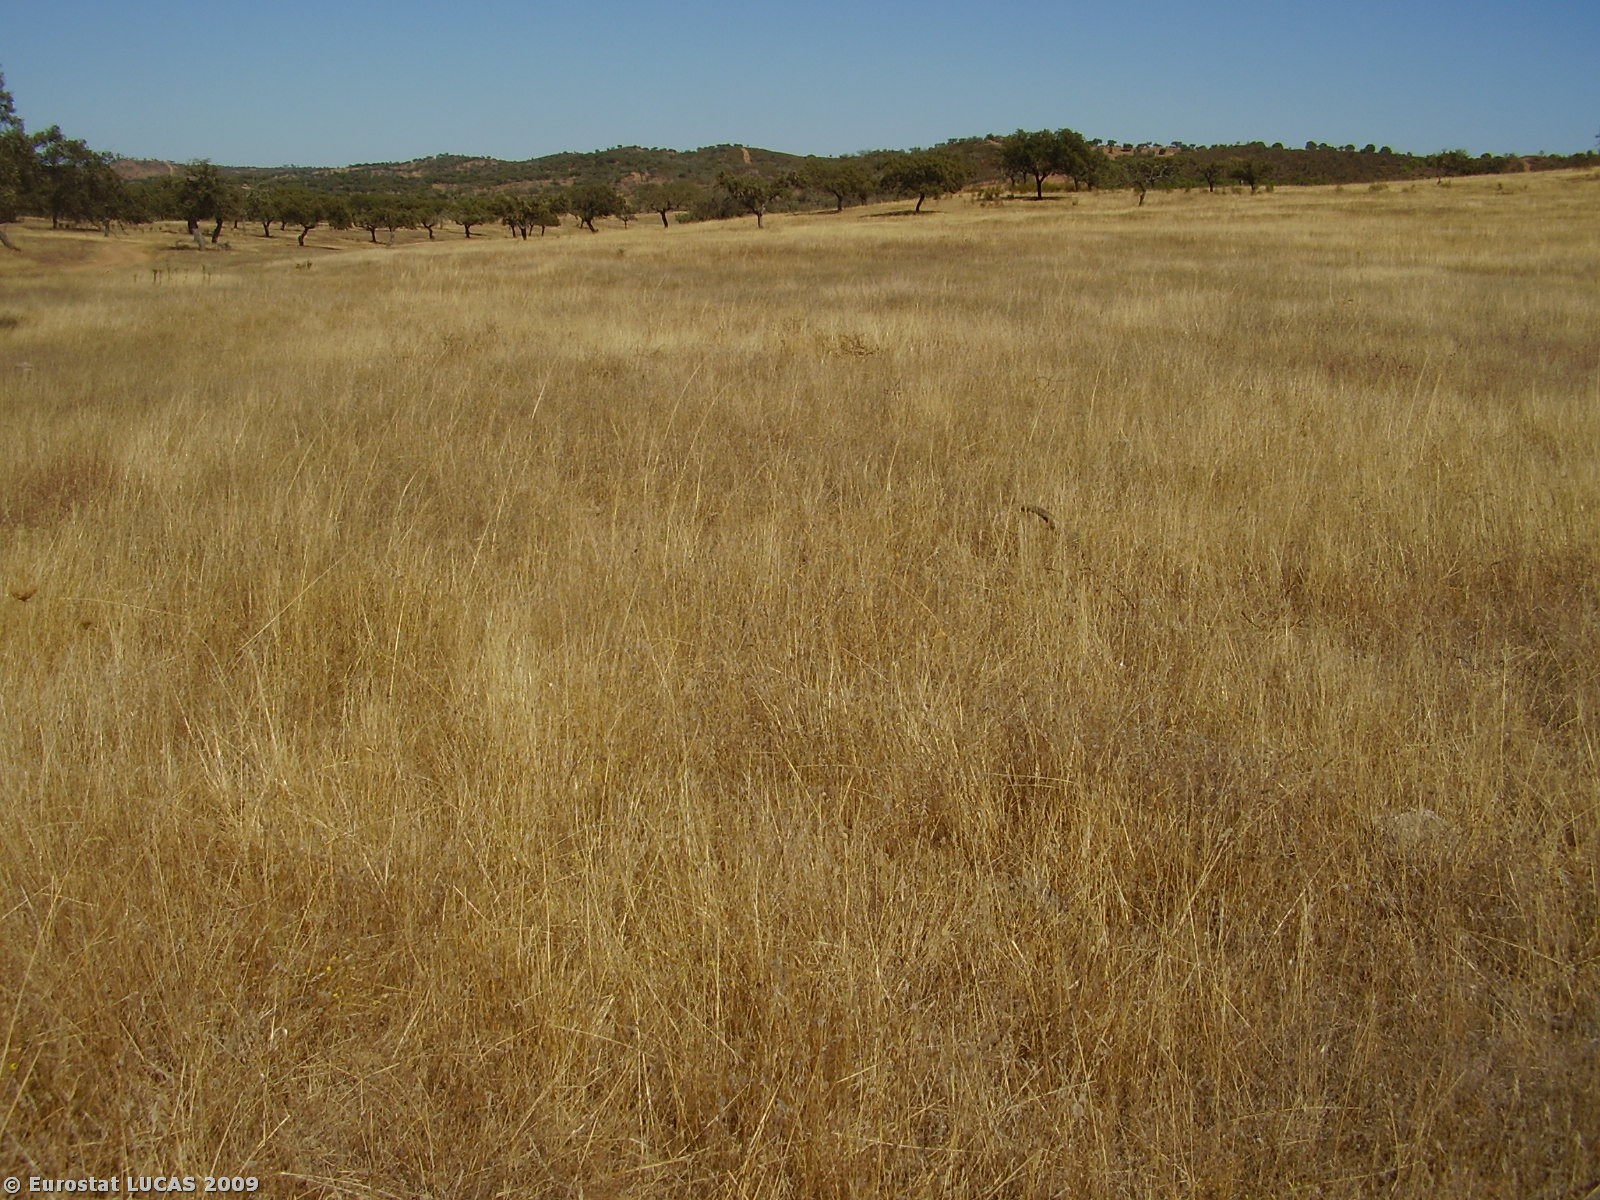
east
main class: Grassland
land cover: Grassland without tree/shrub cover
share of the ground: > 75 %
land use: Fallow land
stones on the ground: 25 - 50 %
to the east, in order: Grassland without tree/shrub cover; Grassland with sparse tree/shrub cover
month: July
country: PT
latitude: 37.8834
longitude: -7.5155
